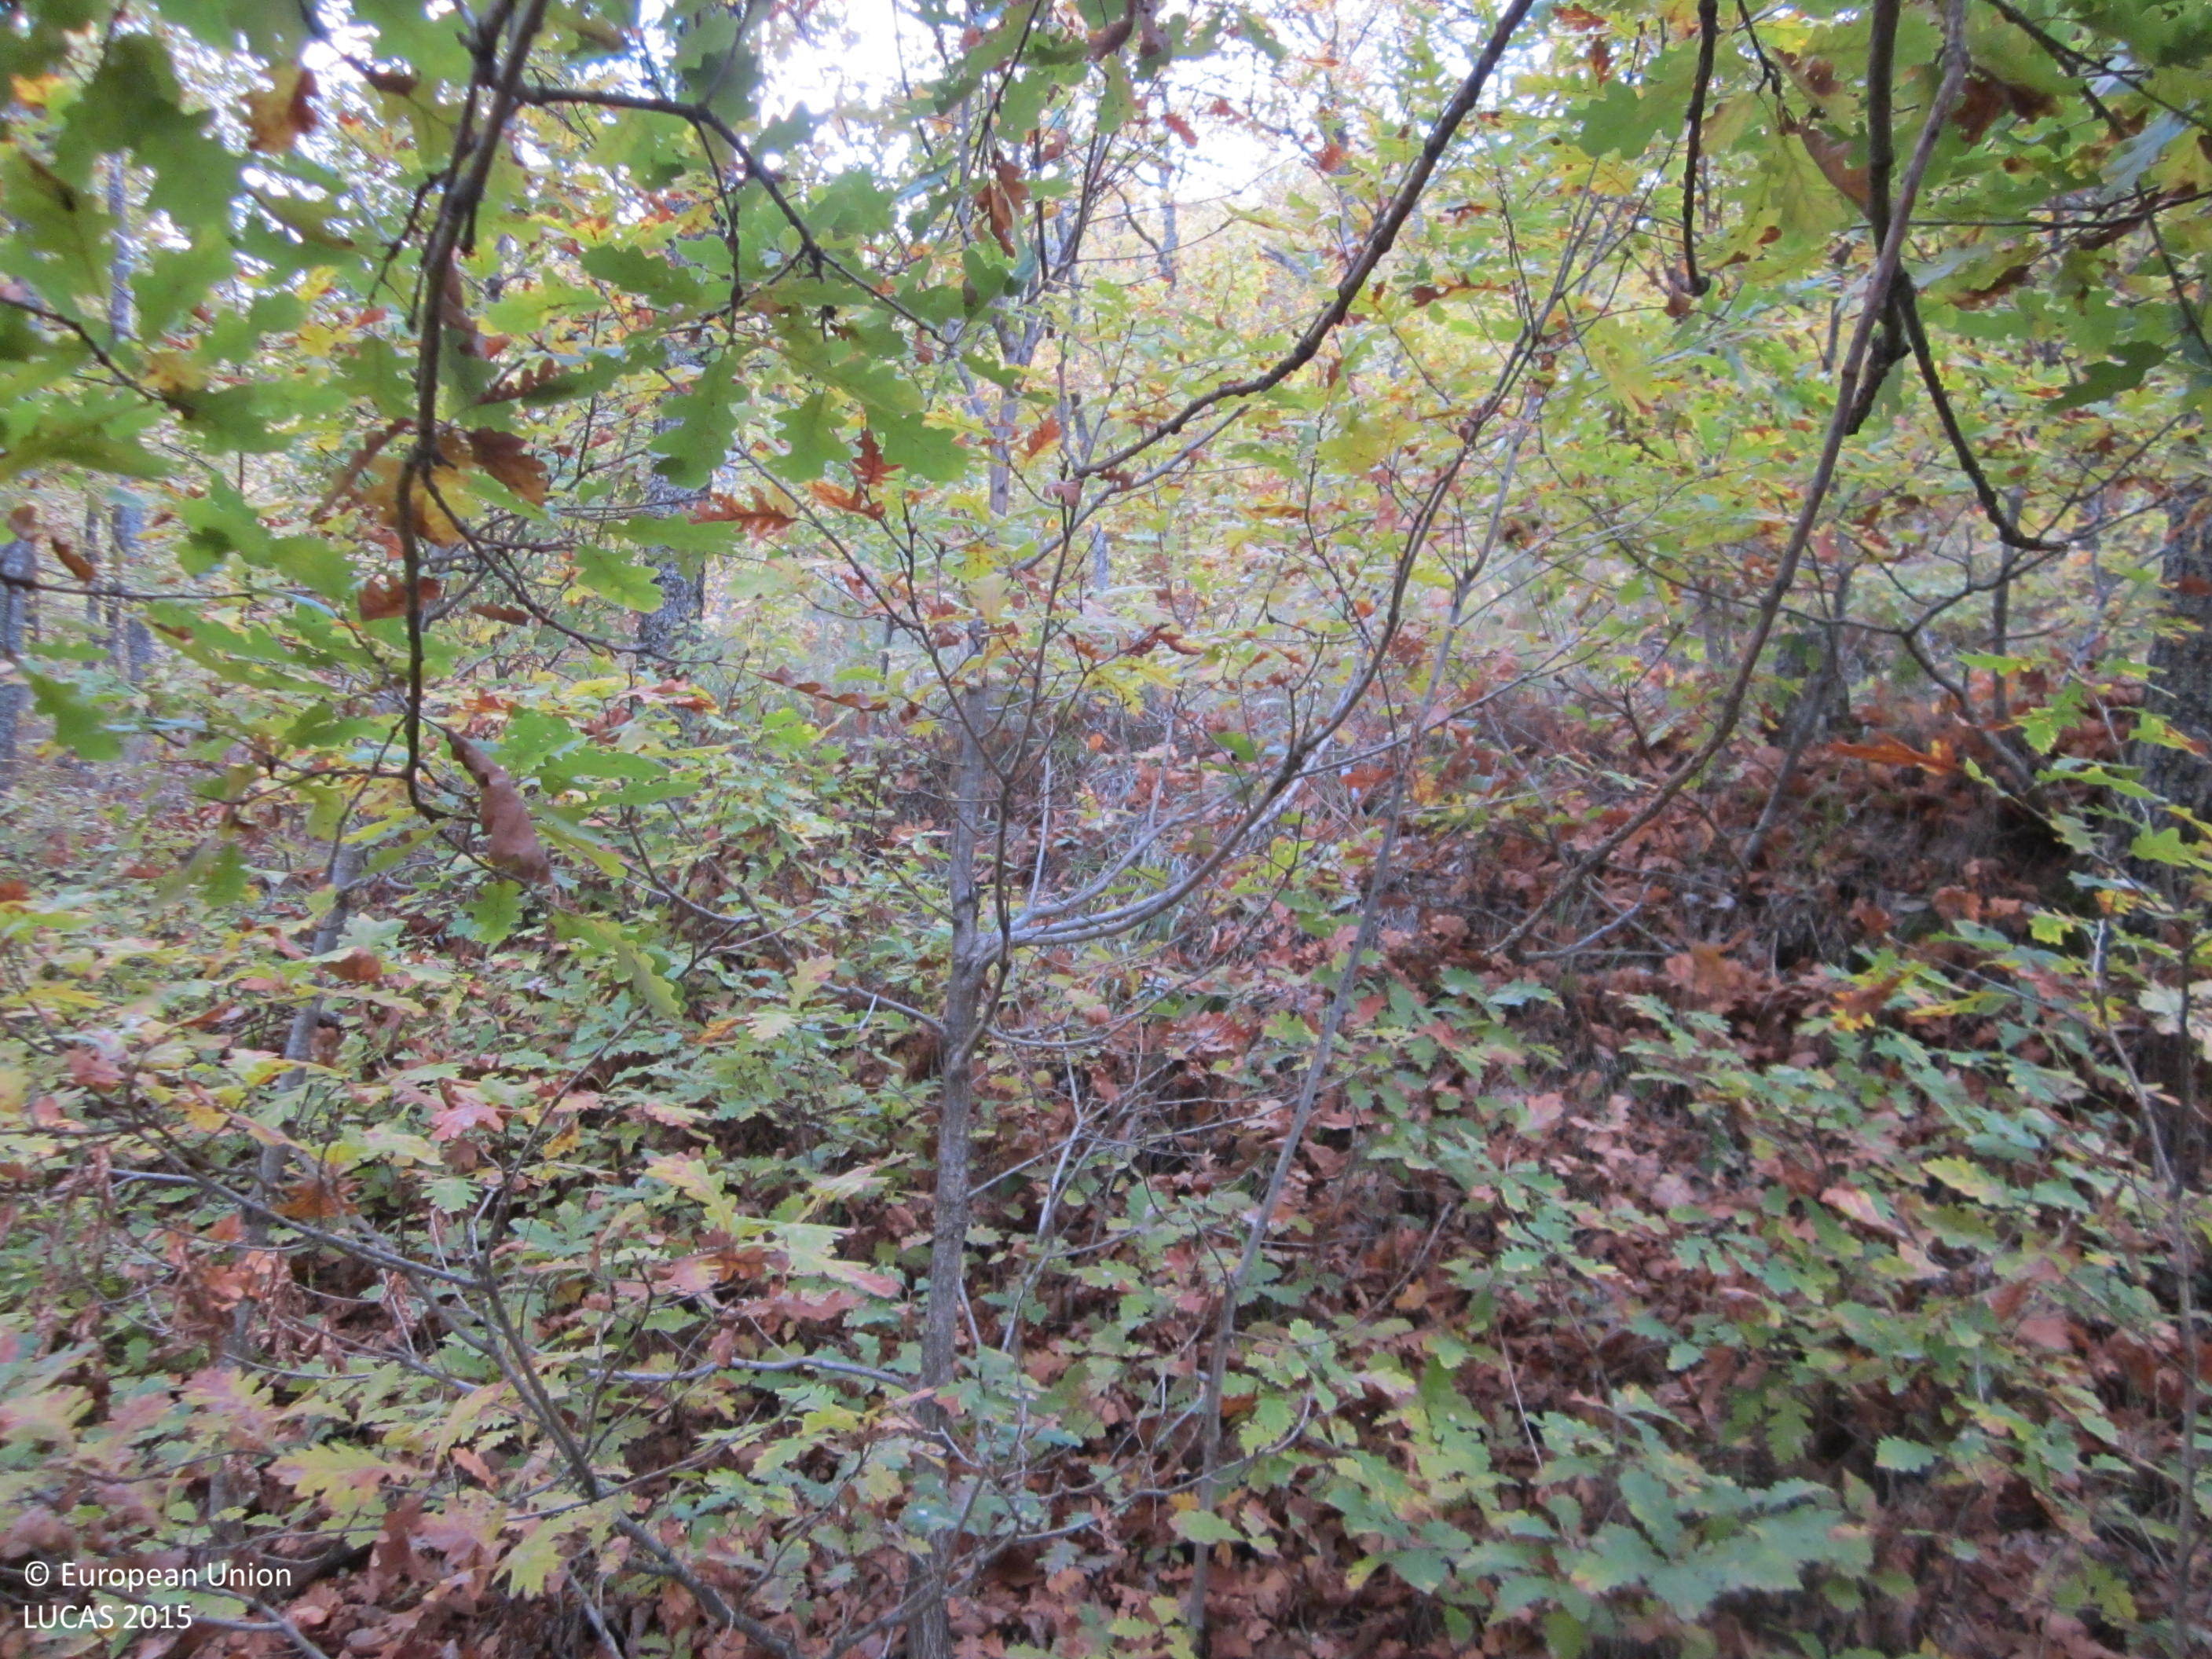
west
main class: Woodland
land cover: Broadleaved woodland
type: acidophilous oak and oak-birch forest
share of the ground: > 75 %
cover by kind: broadleaved forest trees 90 %, shrubs 5 %, herbaceous plants 5 %
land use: Forestry
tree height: > 5 m
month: November
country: BG
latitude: 41.3632
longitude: 25.8301
